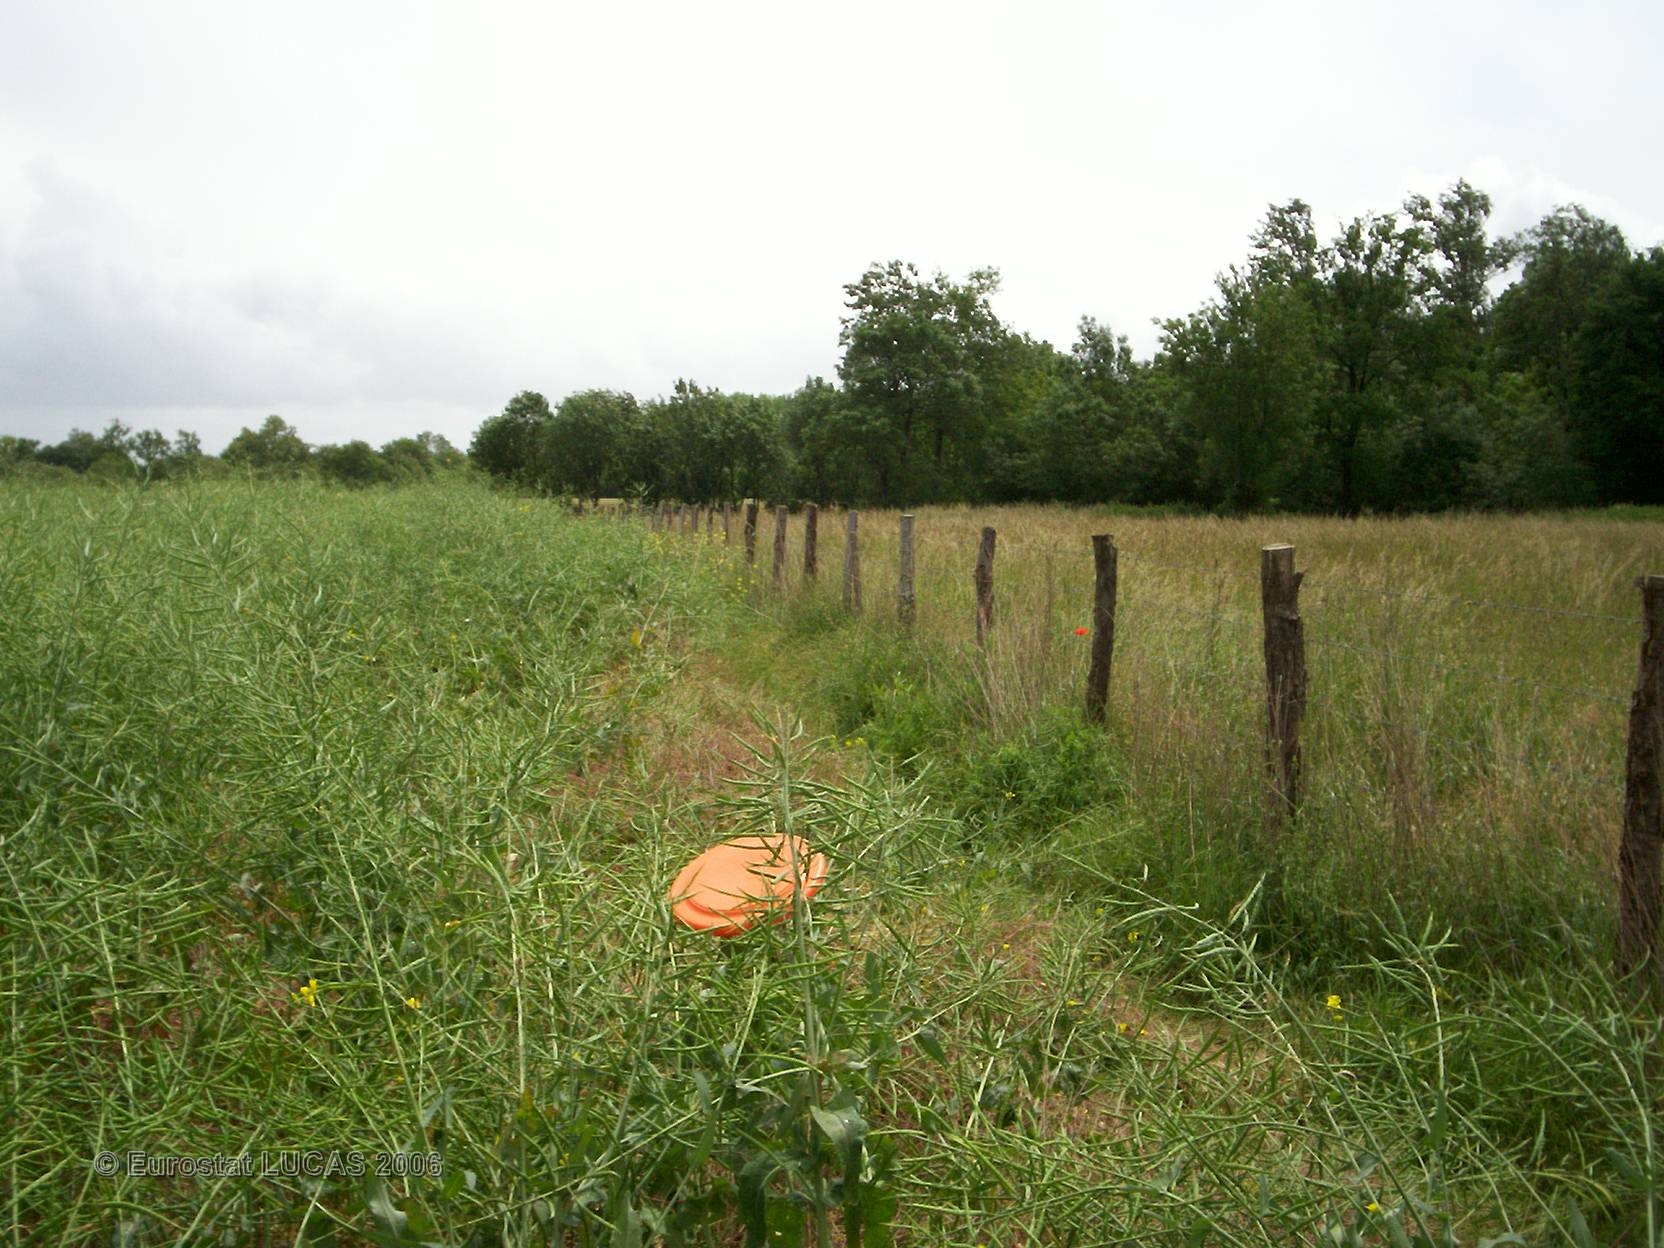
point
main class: Cropland
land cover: Rape and turnip rape
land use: Agriculture (excluding fallow land and kitchen gardens)
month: May
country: FR
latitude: 46.4187
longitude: -0.8155
